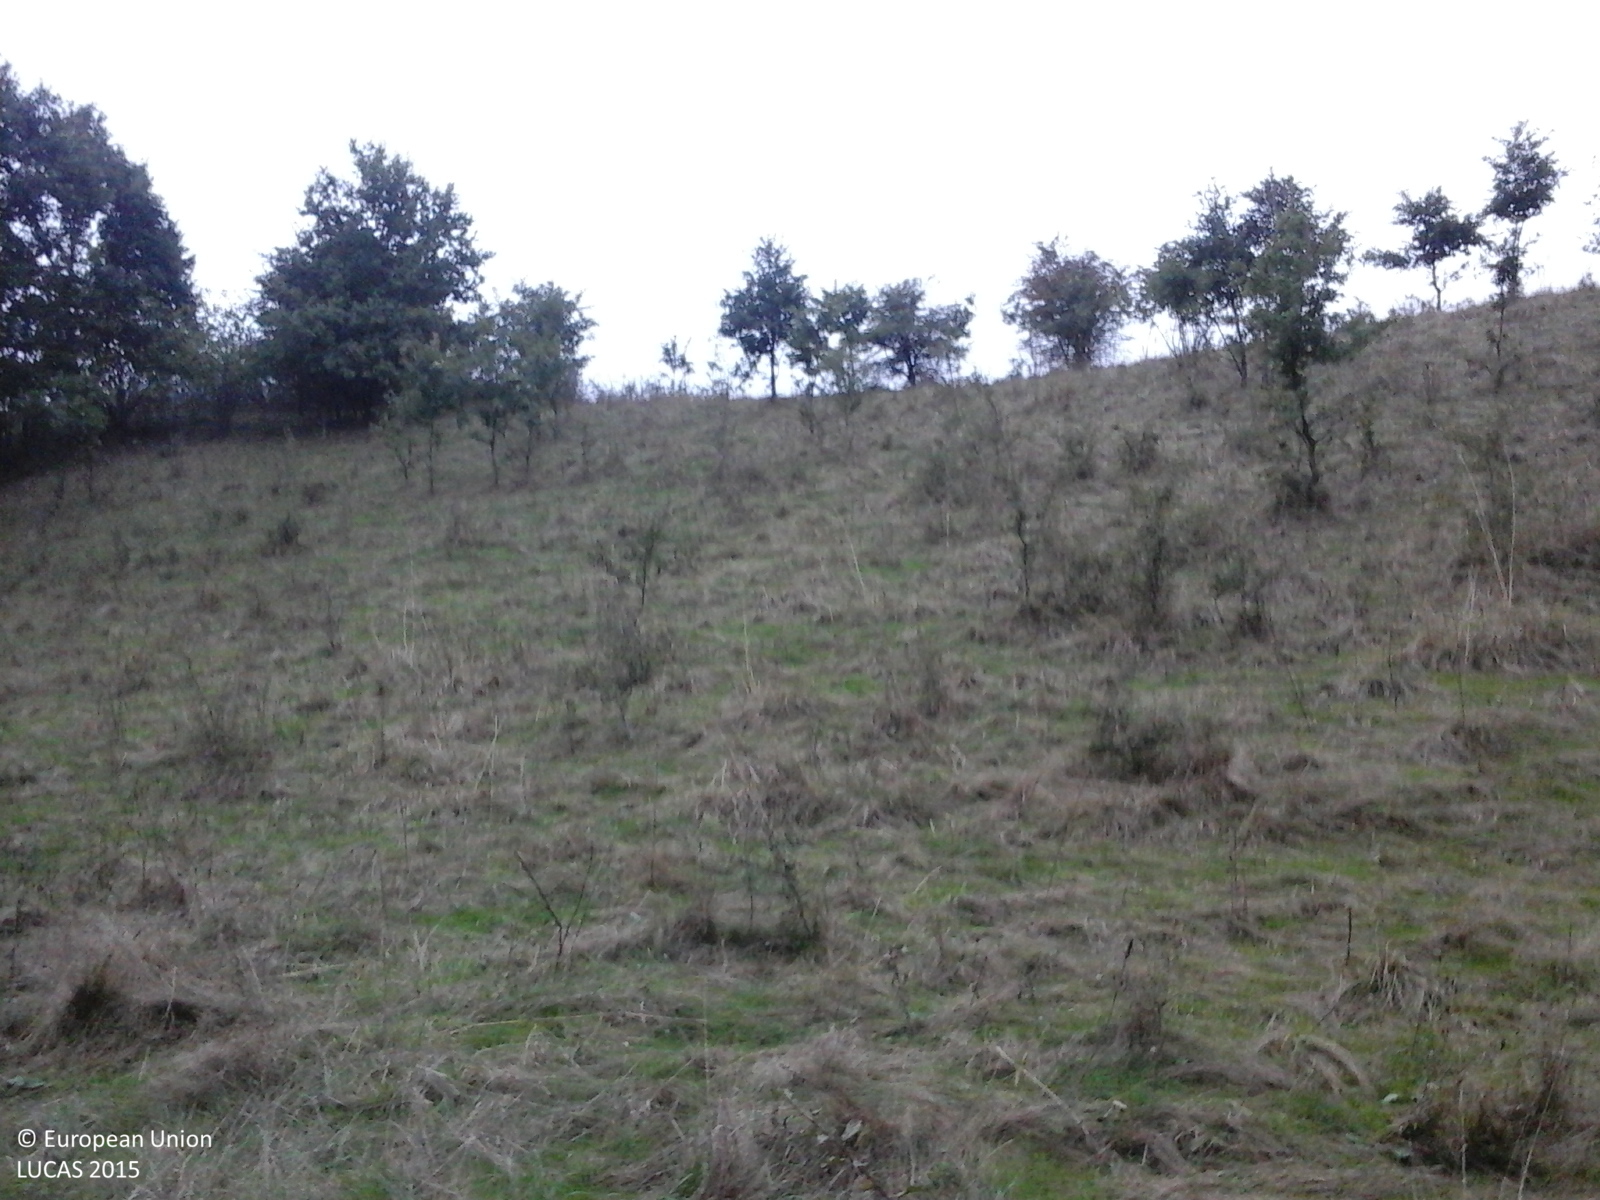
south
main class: Grassland
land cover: Grassland with sparse tree/shrub cover
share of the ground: > 75 %
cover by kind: herbaceous plants 90 %, broadleaved forest trees 5 %, shrubs 5 %
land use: Agriculture (excluding fallow land and kitchen gardens)
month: September
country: RO
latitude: 45.8868
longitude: 23.3992
